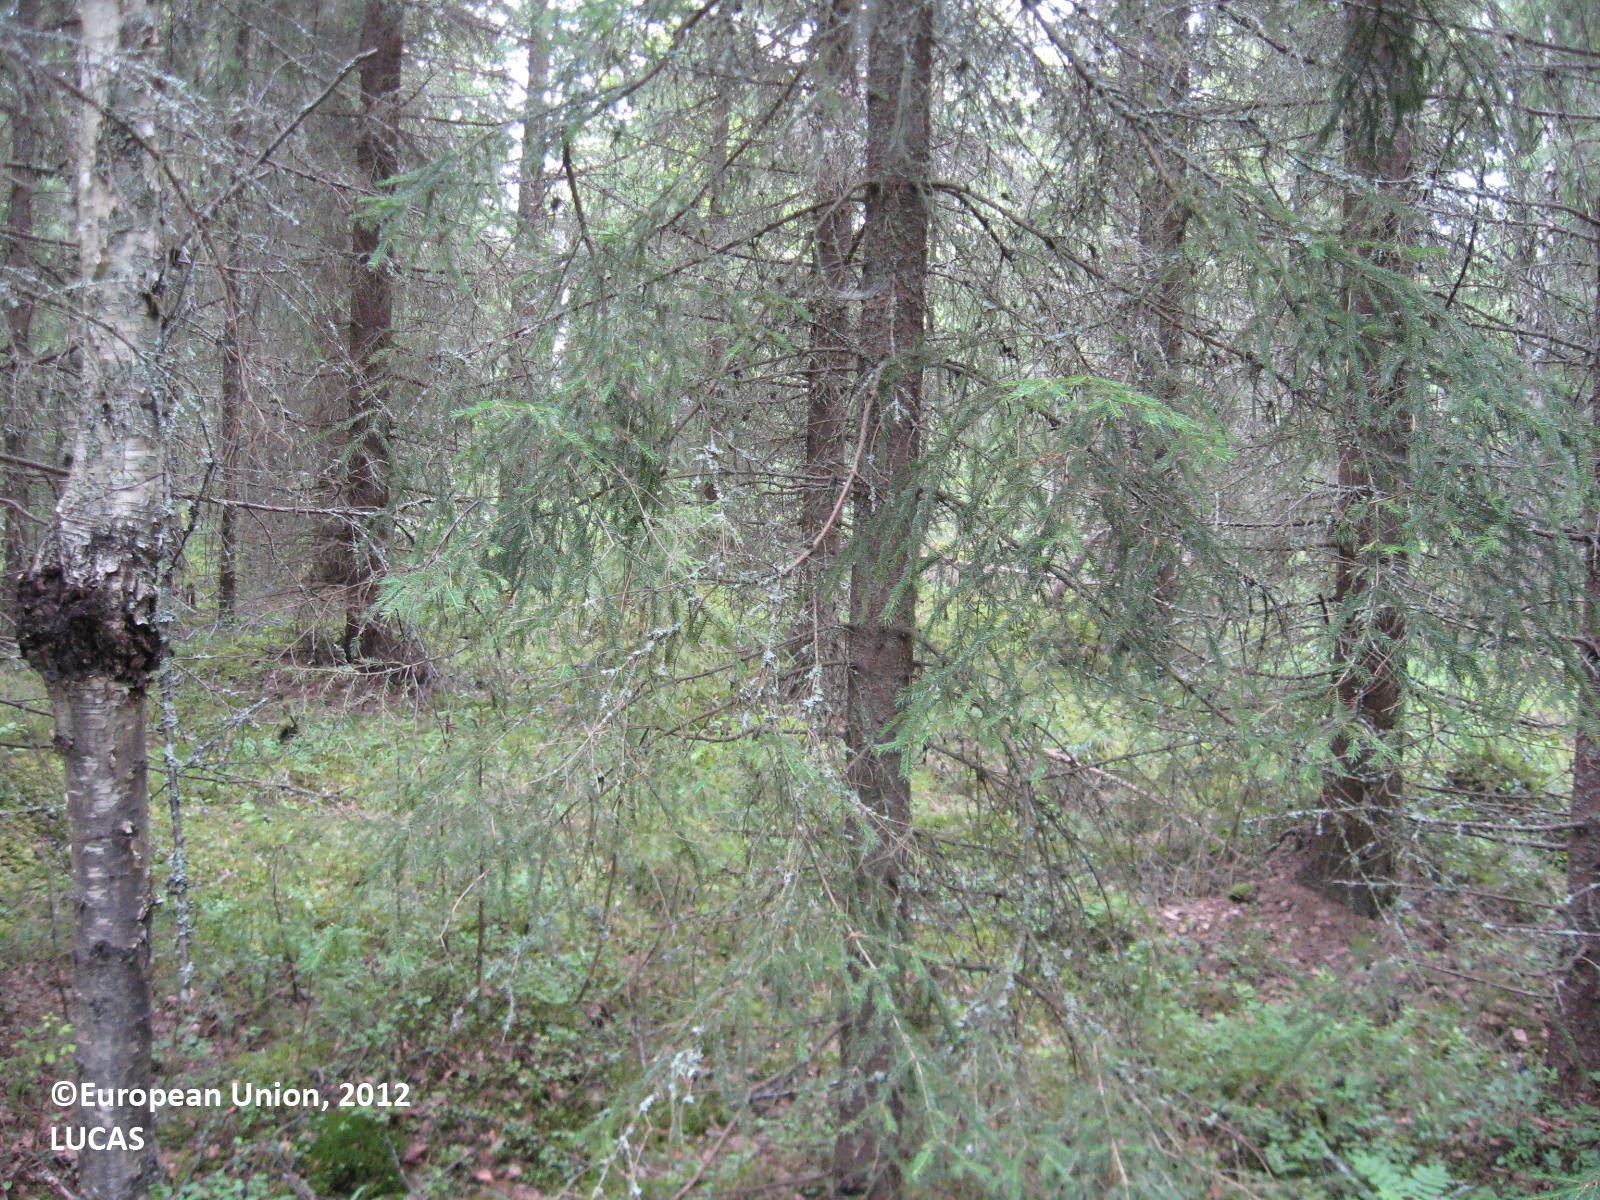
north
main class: Woodland
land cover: Spruce dominated coniferous woodland
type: boreal forest
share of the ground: > 75 %
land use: Forestry
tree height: > 5 m
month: July
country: FI
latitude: 62.5387
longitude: 21.2168
